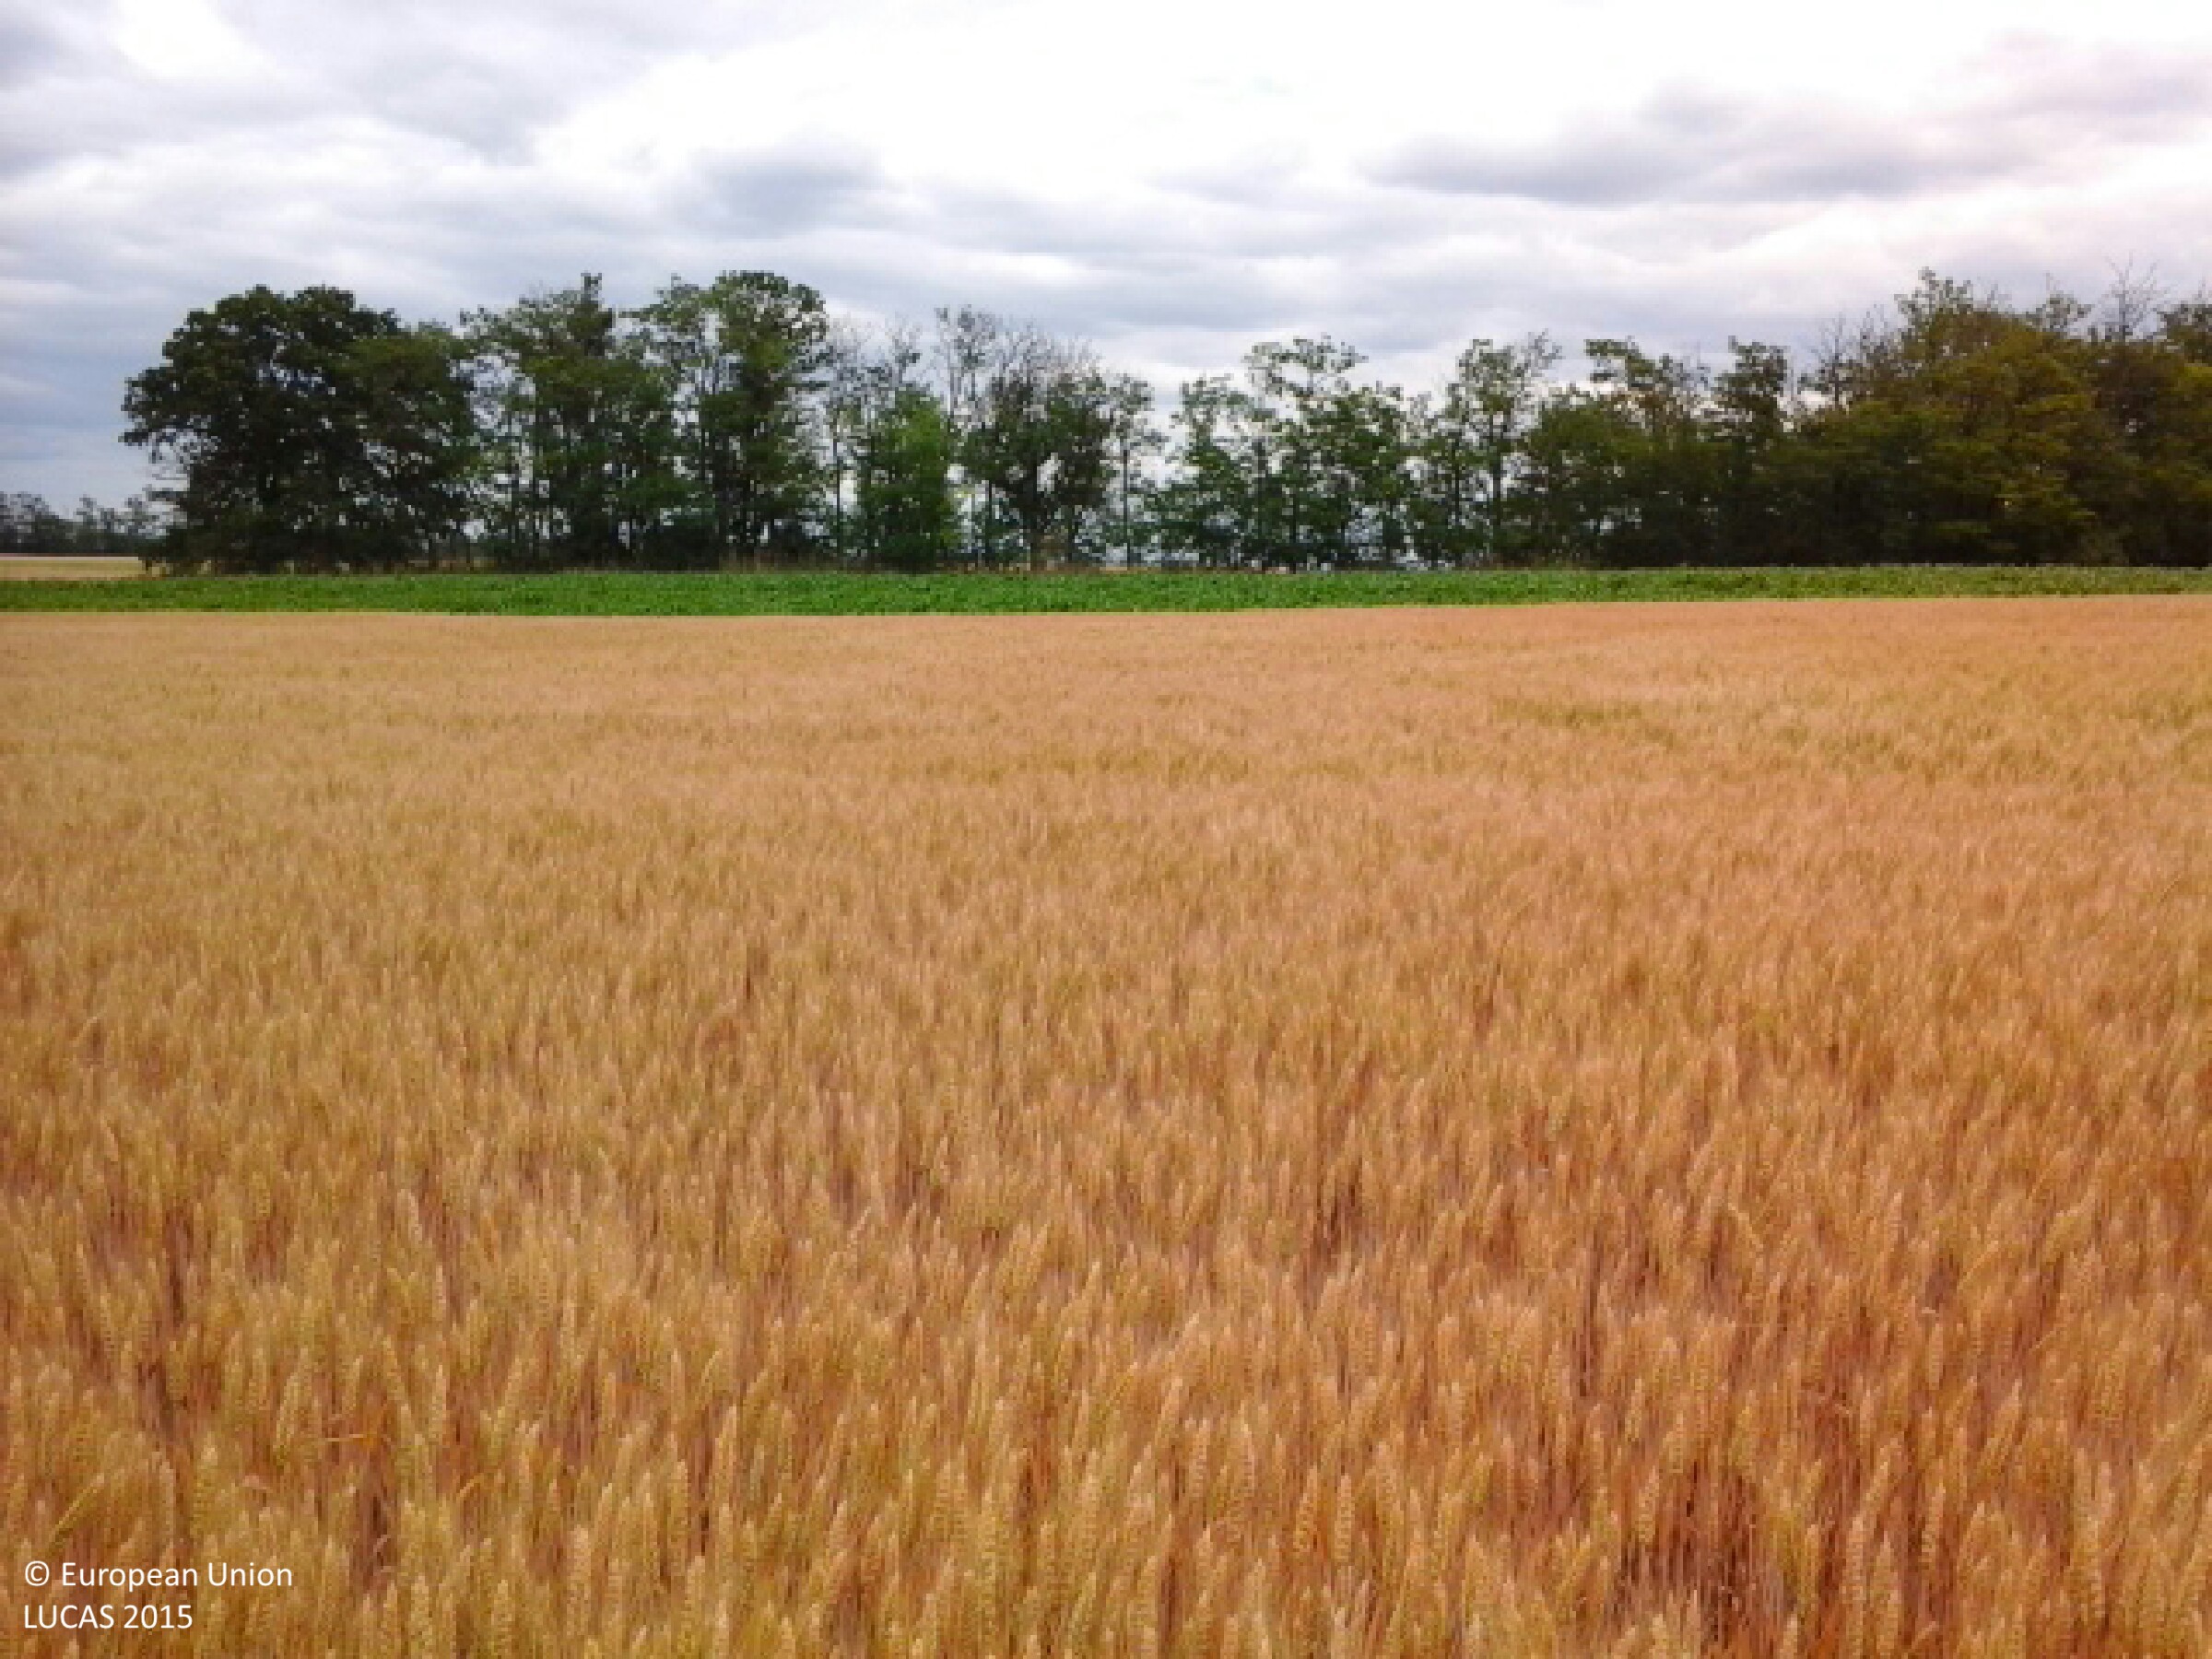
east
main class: Cropland
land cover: Triticale
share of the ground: > 75 %
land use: Agriculture (excluding fallow land and kitchen gardens)
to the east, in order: Triticale; Maize; Broadleaved woodland; Spontaneously vegetated surfaces; Rape and turnip rape
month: June
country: HU
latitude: 47.9353
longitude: 21.4354
